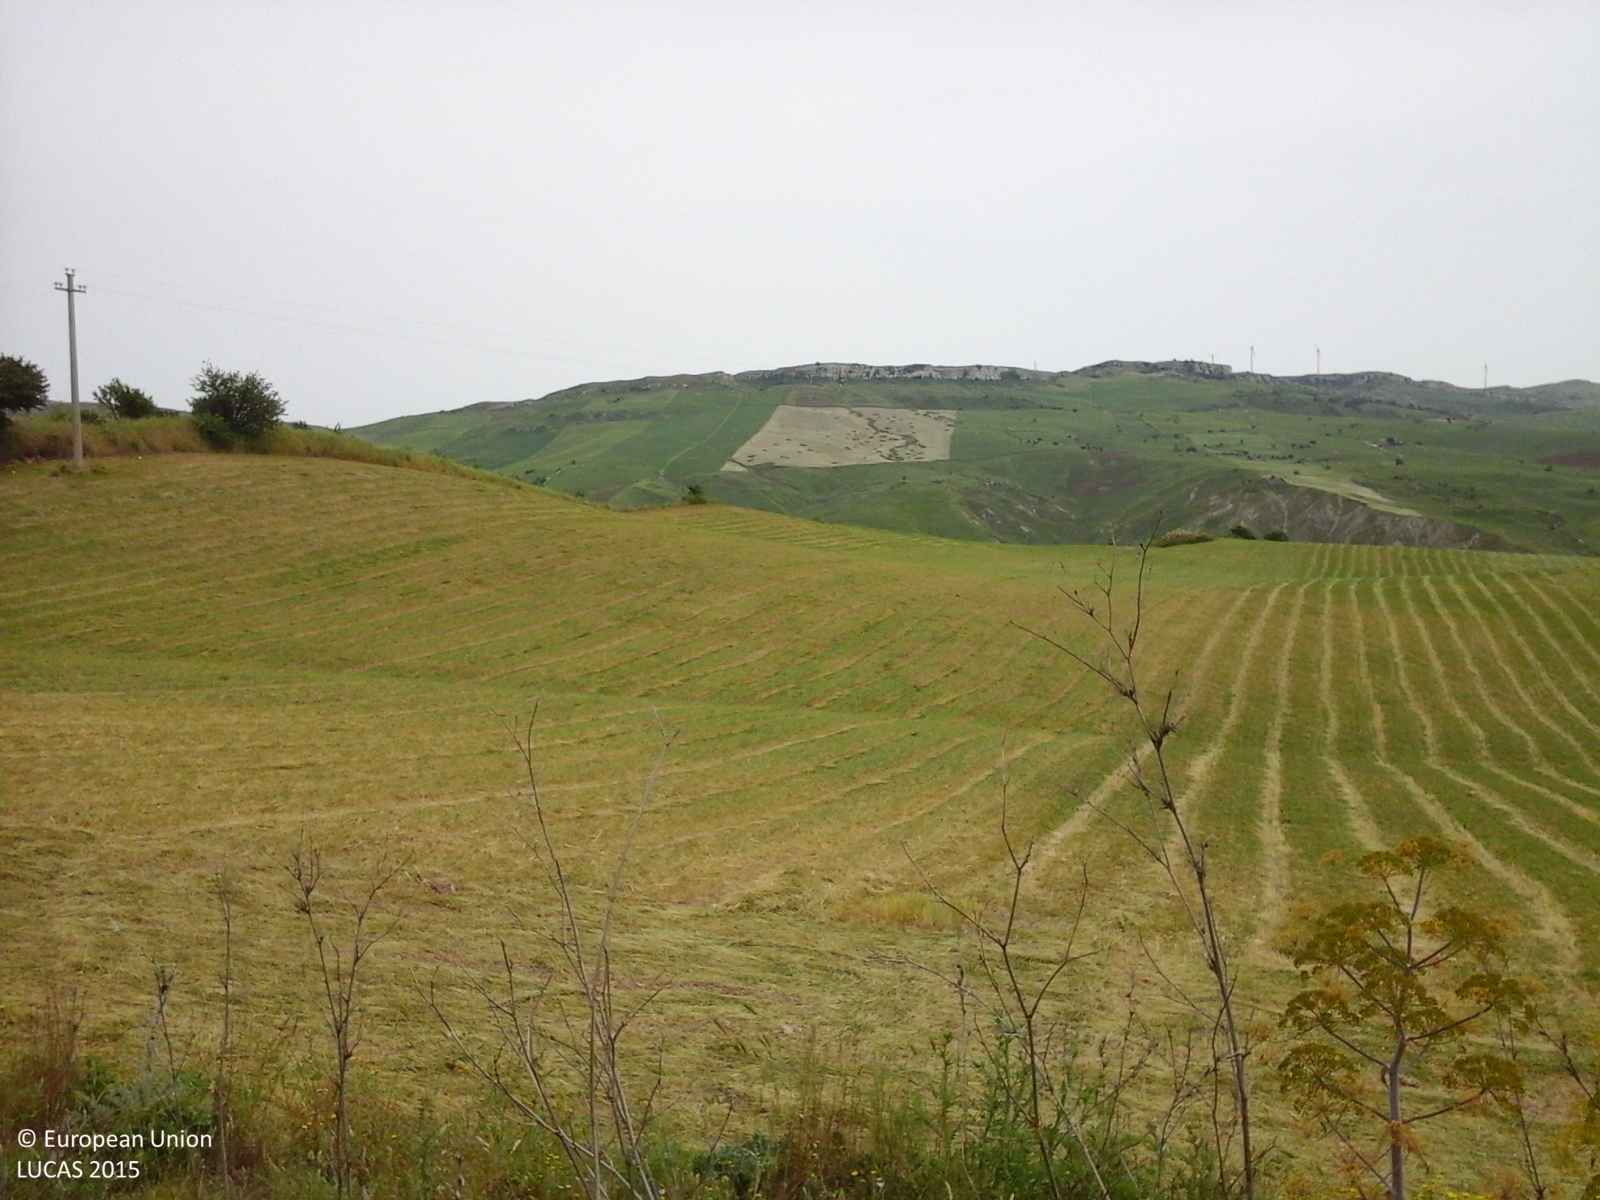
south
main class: Cropland
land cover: Durum wheat
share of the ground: > 75 %
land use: Agriculture (excluding fallow land and kitchen gardens)
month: May
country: IT
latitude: 37.6636
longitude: 13.9952
